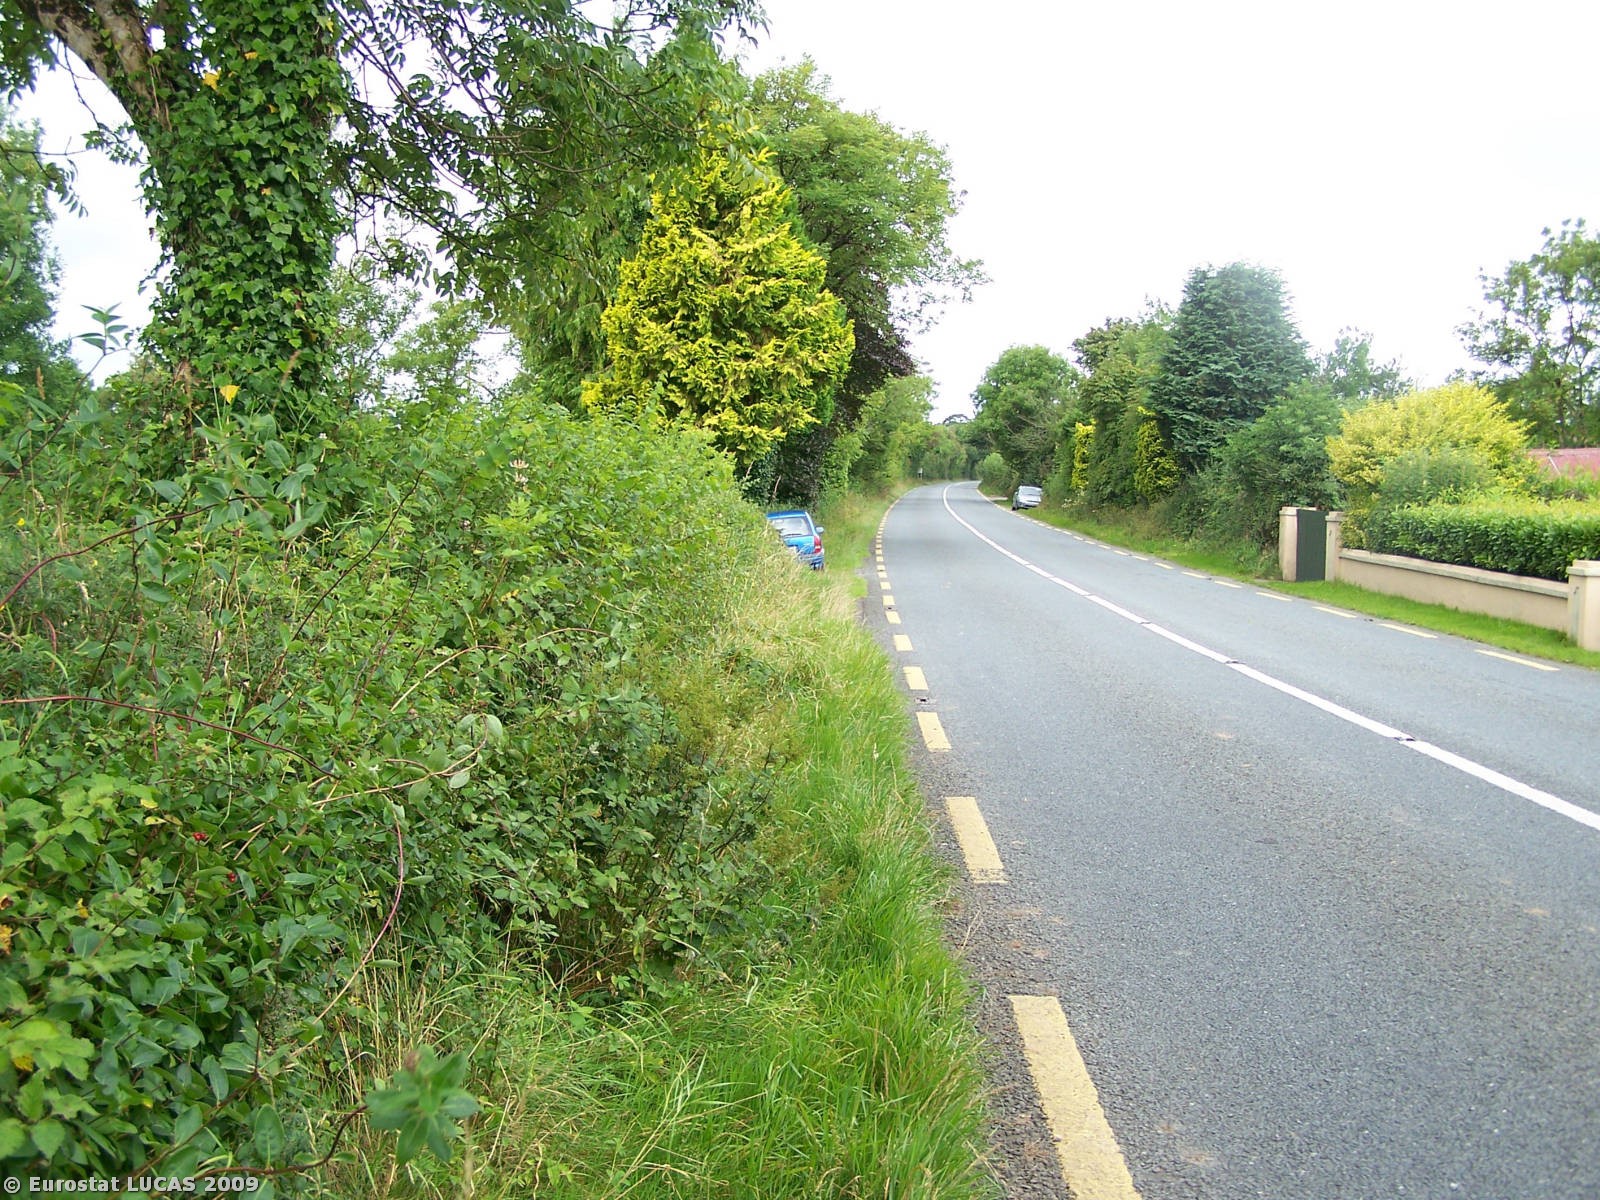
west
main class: Grassland
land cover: Grassland without tree/shrub cover
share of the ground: > 75 %
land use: Agriculture (excluding fallow land and kitchen gardens)
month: August
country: IE
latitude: 52.1432
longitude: -8.8378
